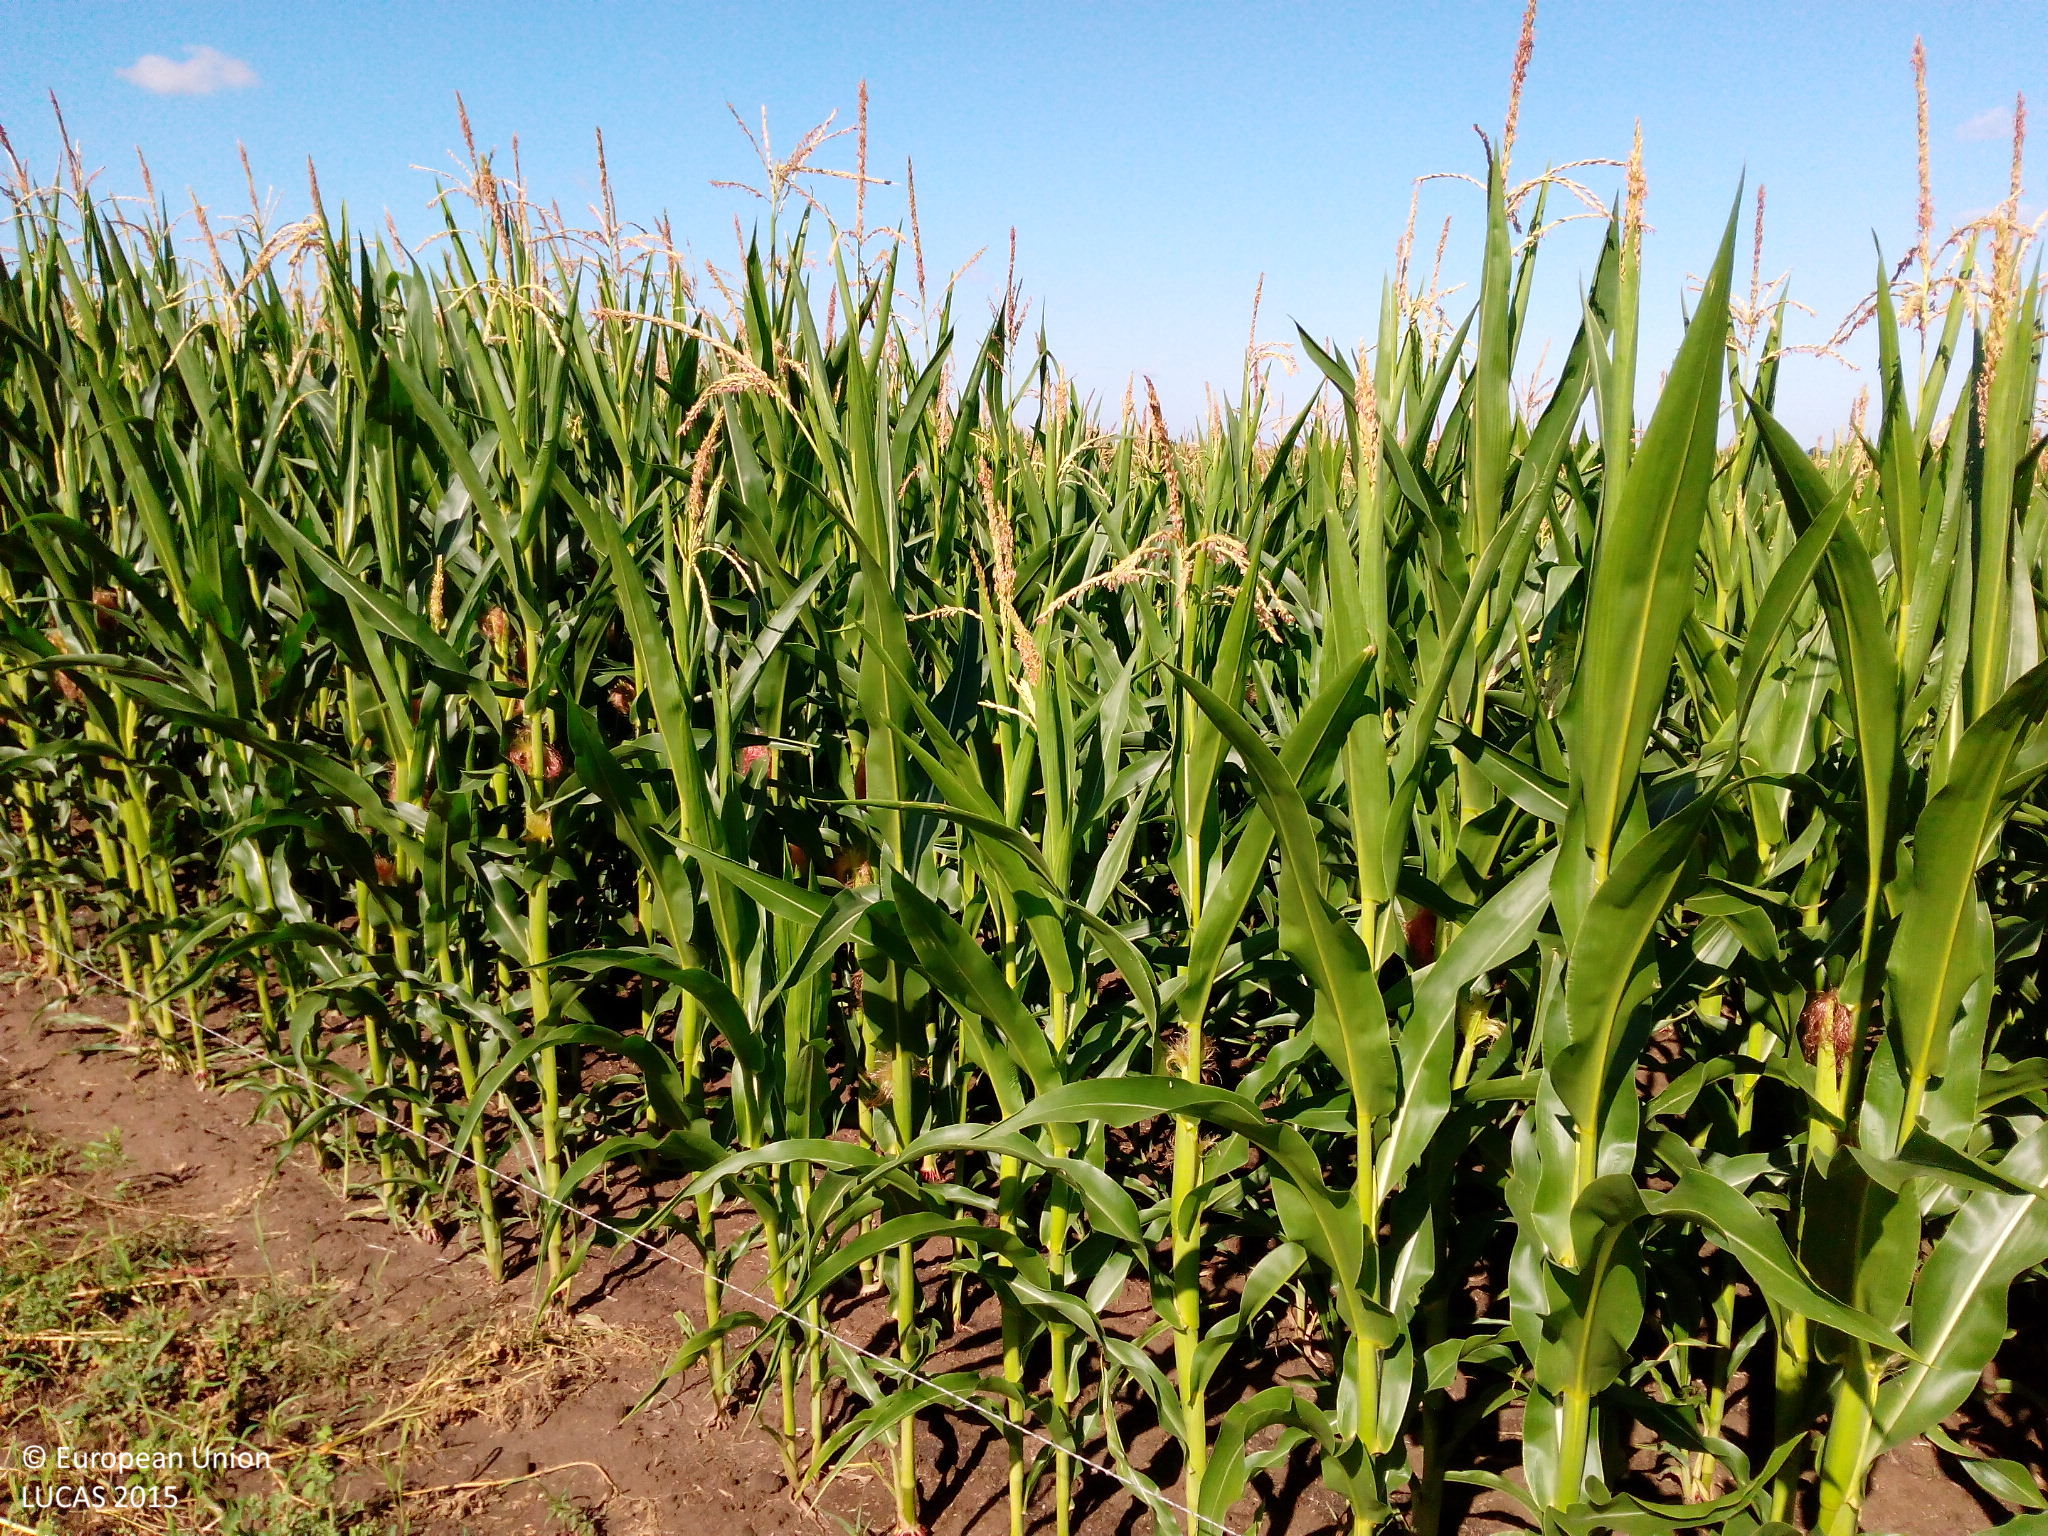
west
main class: Cropland
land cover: Maize
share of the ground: > 75 %
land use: Agriculture (excluding fallow land and kitchen gardens)
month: July
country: DE
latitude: 52.7882
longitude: 14.2270
